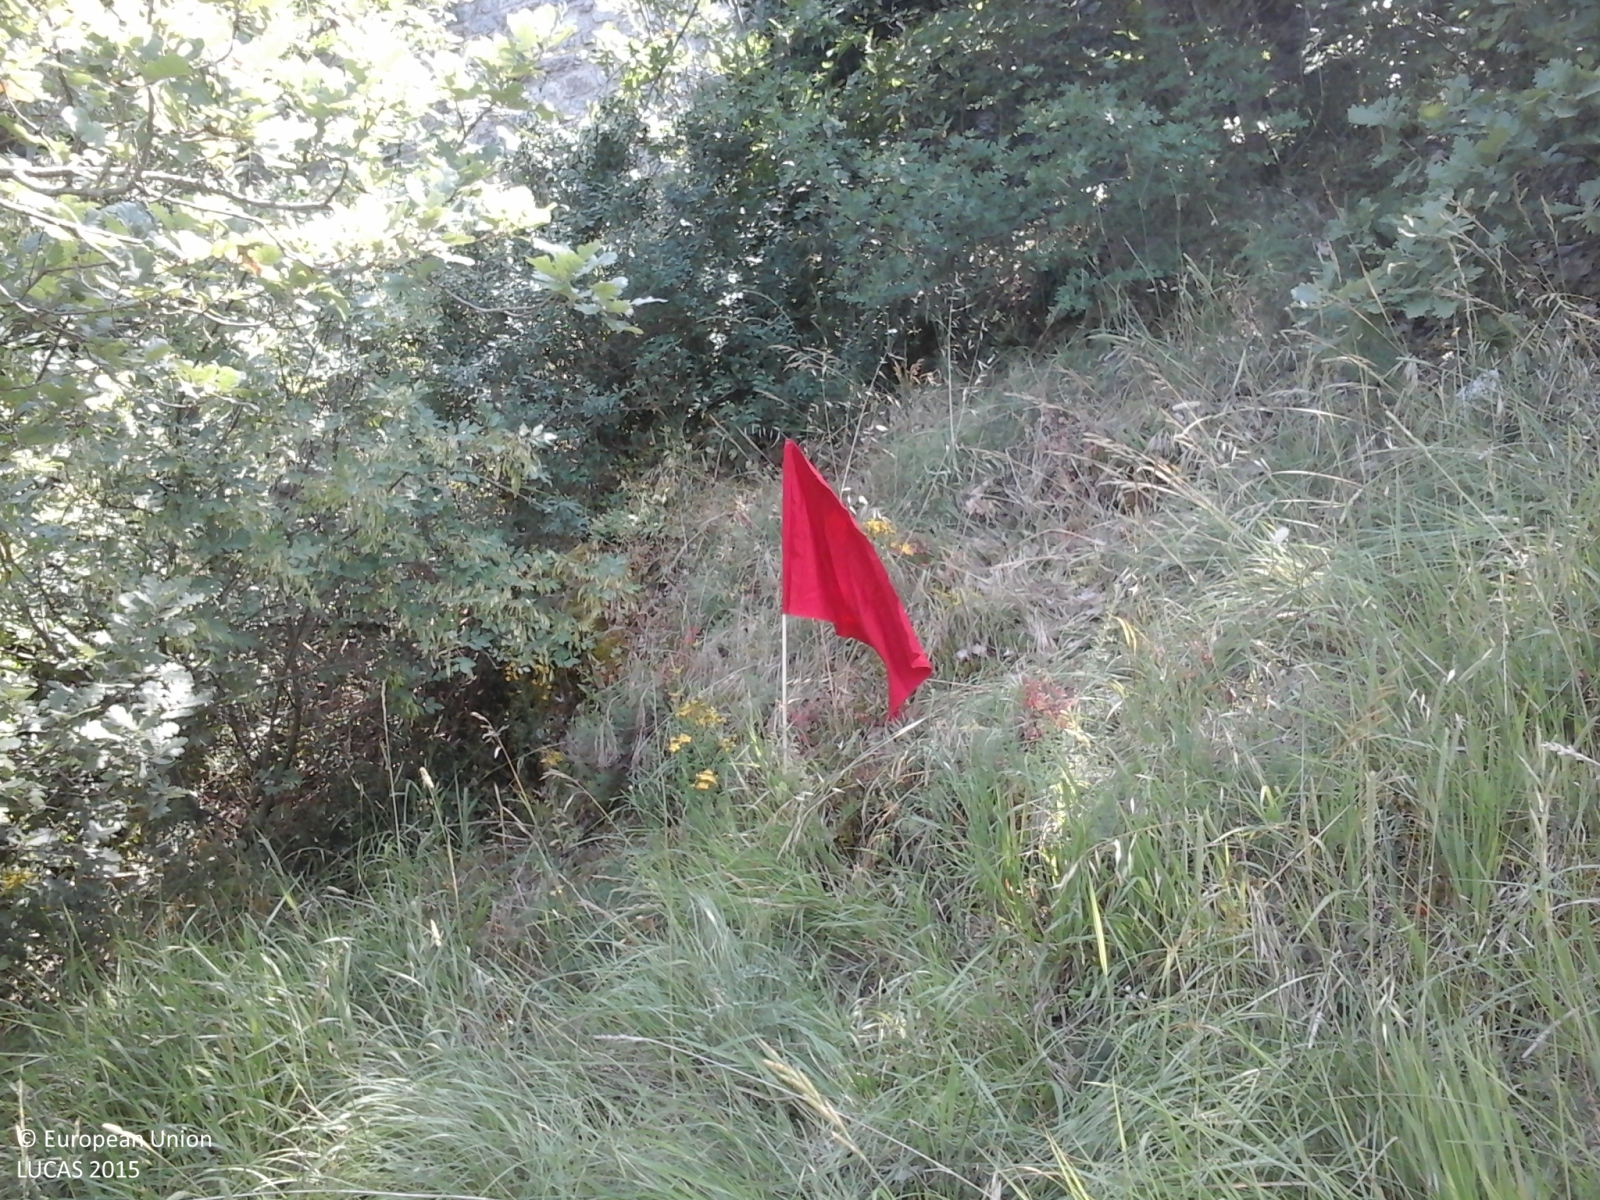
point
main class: Woodland
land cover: Broadleaved woodland
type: thermophilous deciduous forest
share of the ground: > 75 %
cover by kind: broadleaved forest trees 95 %, herbaceous plants 5 %
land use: Forestry
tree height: < 5 m
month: June
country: IT
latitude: 43.1118
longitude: 13.1251
